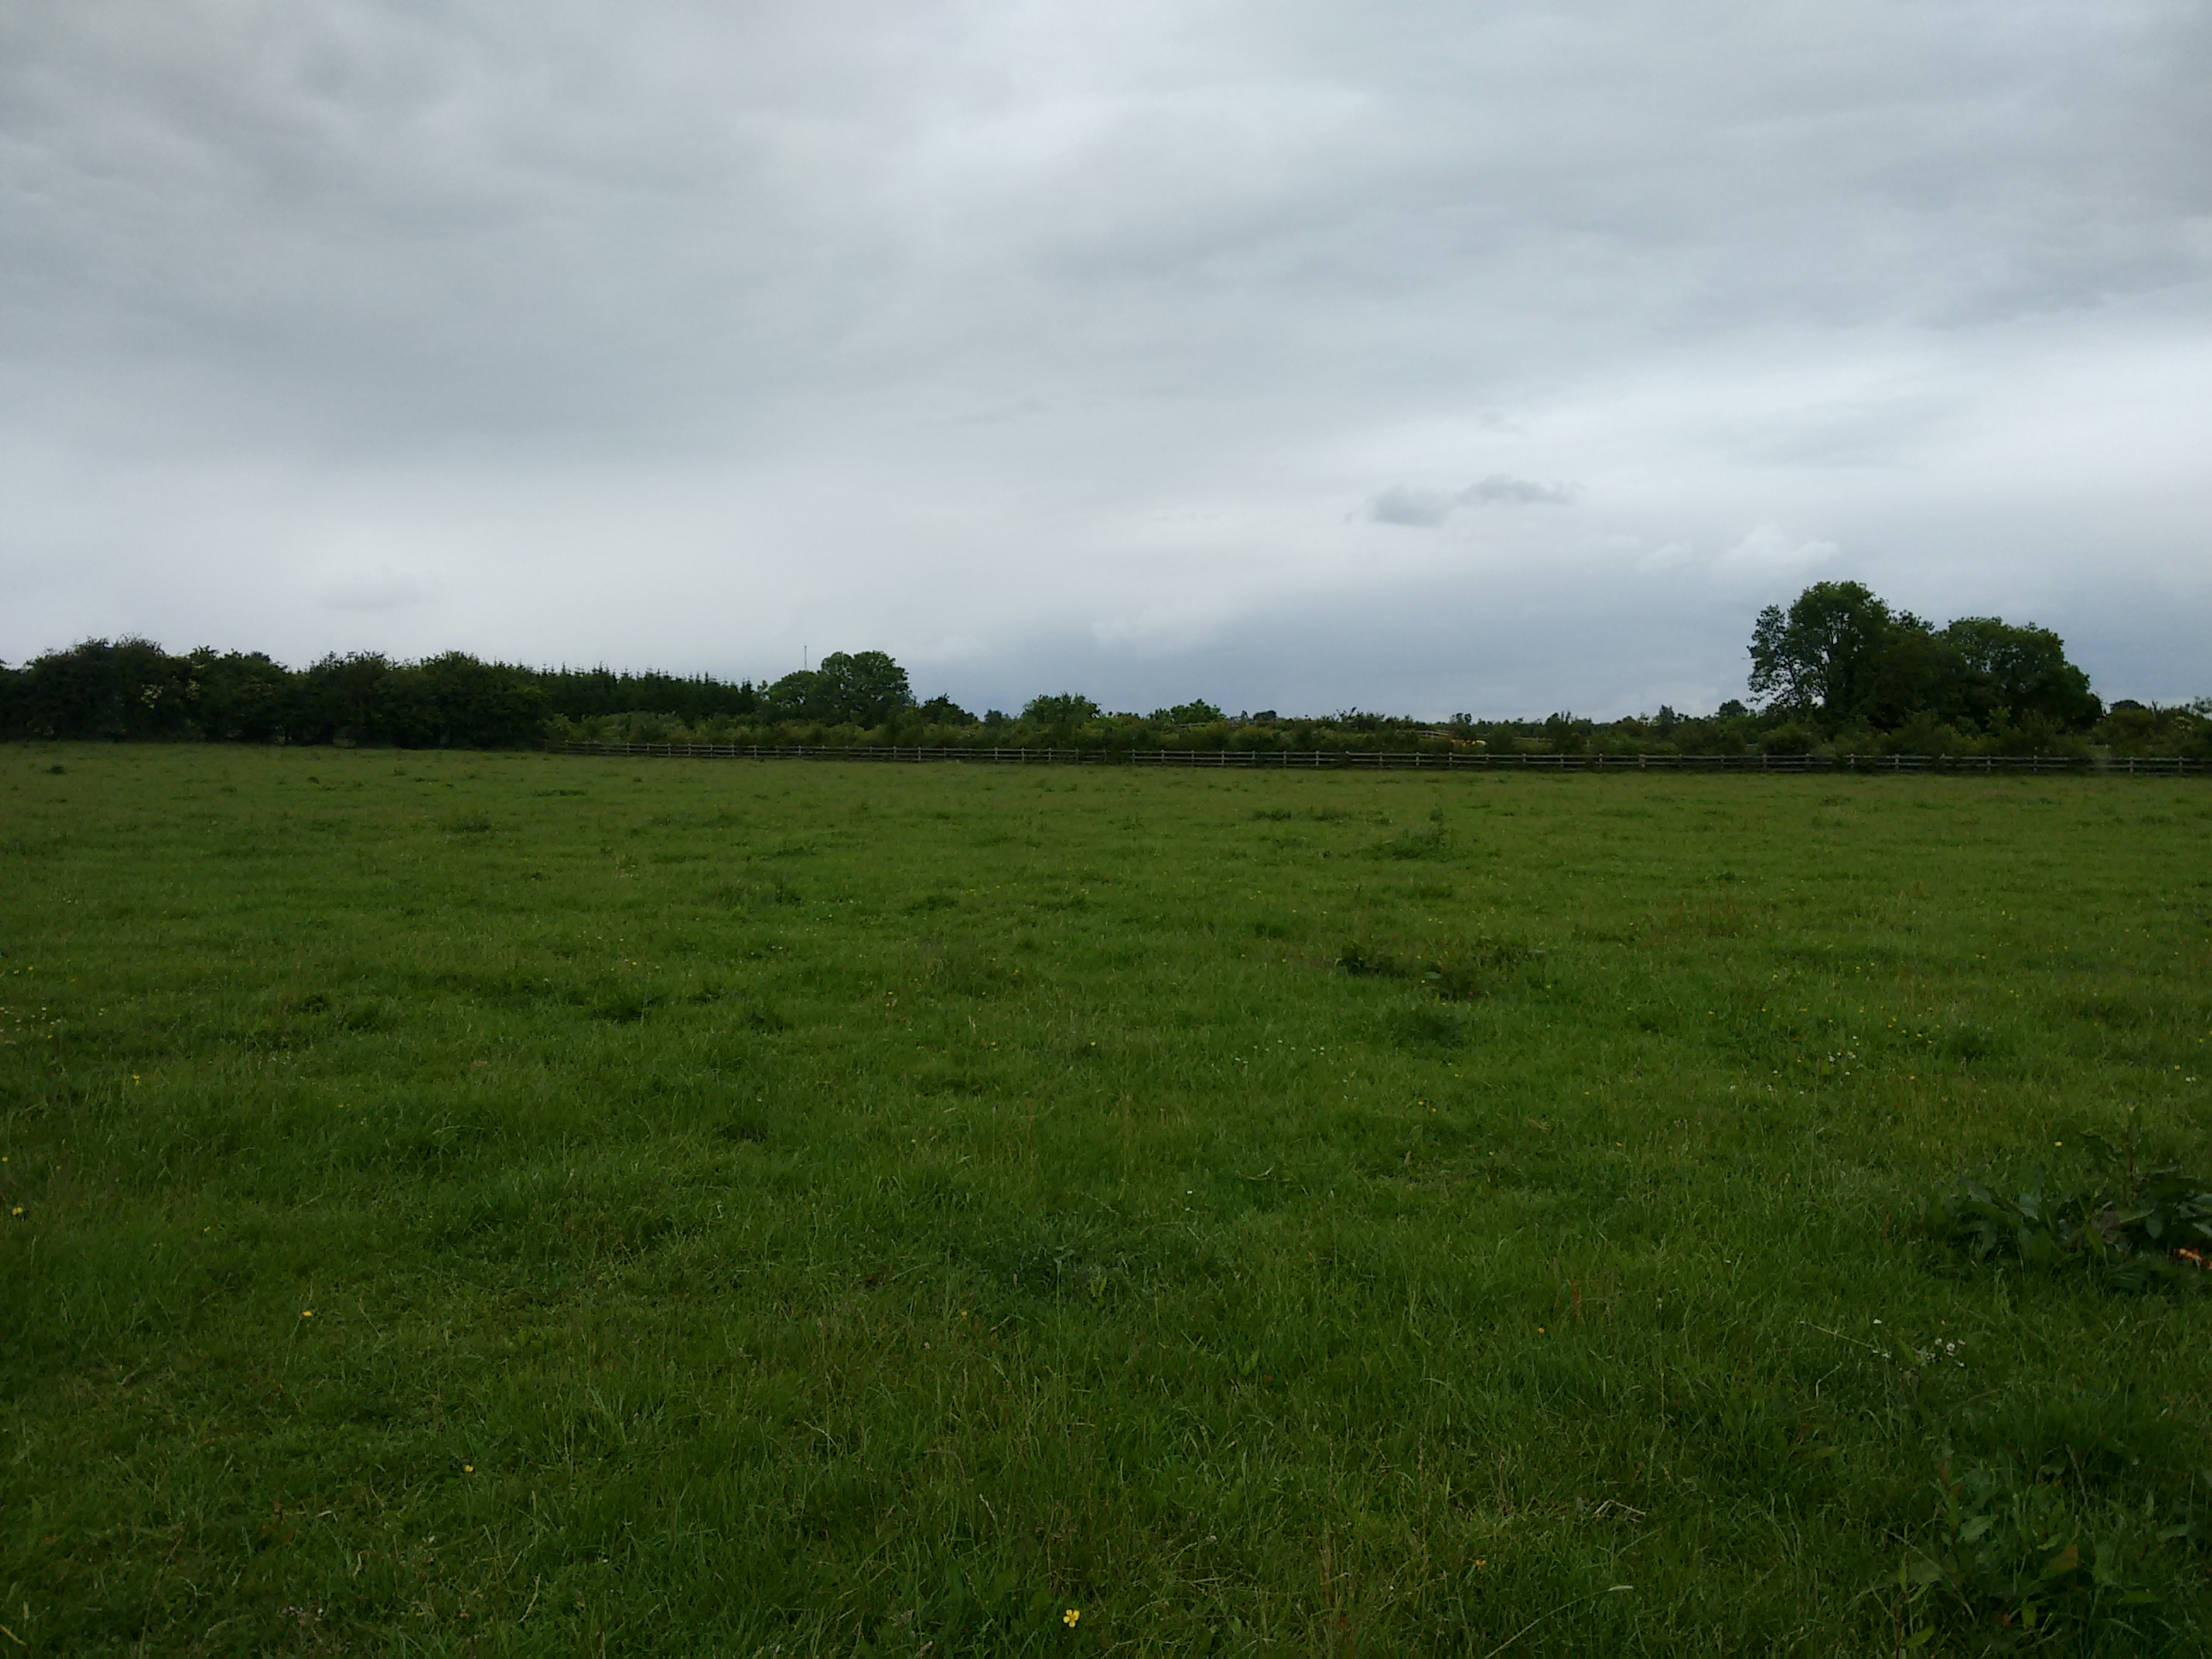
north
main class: Grassland
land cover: Grassland without tree/shrub cover
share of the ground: > 75 %
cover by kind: herbaceous plants 95 %, shrubs 5 %
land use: Agriculture (excluding fallow land and kitchen gardens)
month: June
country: IE
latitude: 53.4025
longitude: -7.8740
